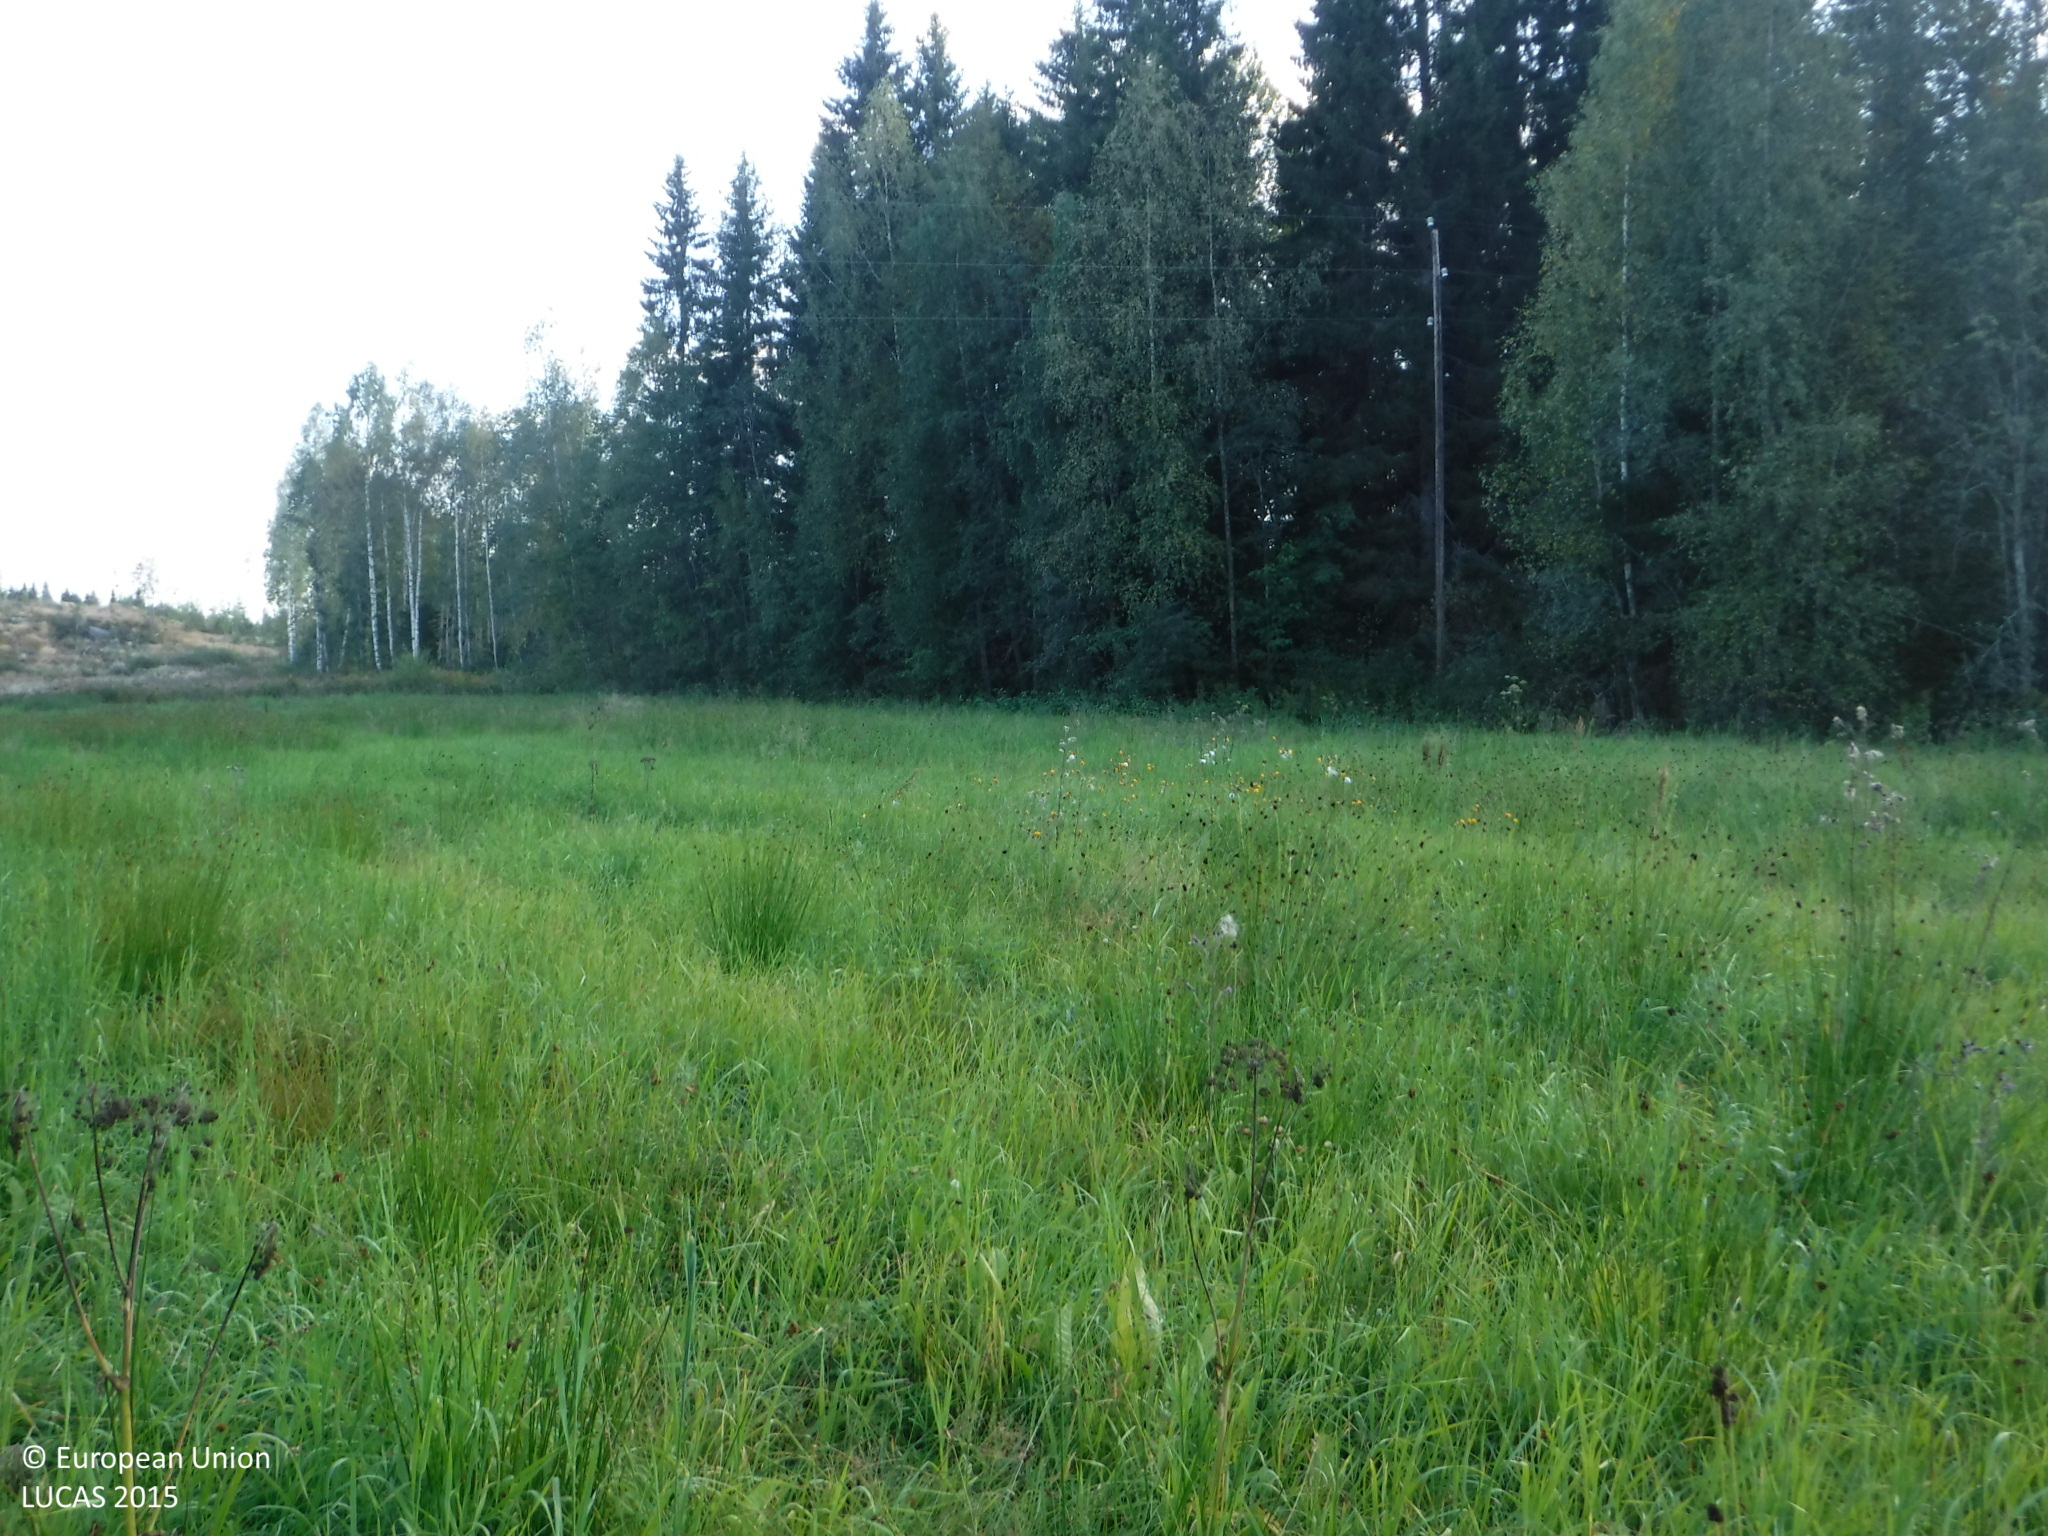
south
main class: Grassland
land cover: Grassland without tree/shrub cover
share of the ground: > 75 %
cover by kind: herbaceous plants 100 %
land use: Agriculture (excluding fallow land and kitchen gardens)
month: September
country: FI
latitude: 61.7686
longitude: 22.3966
